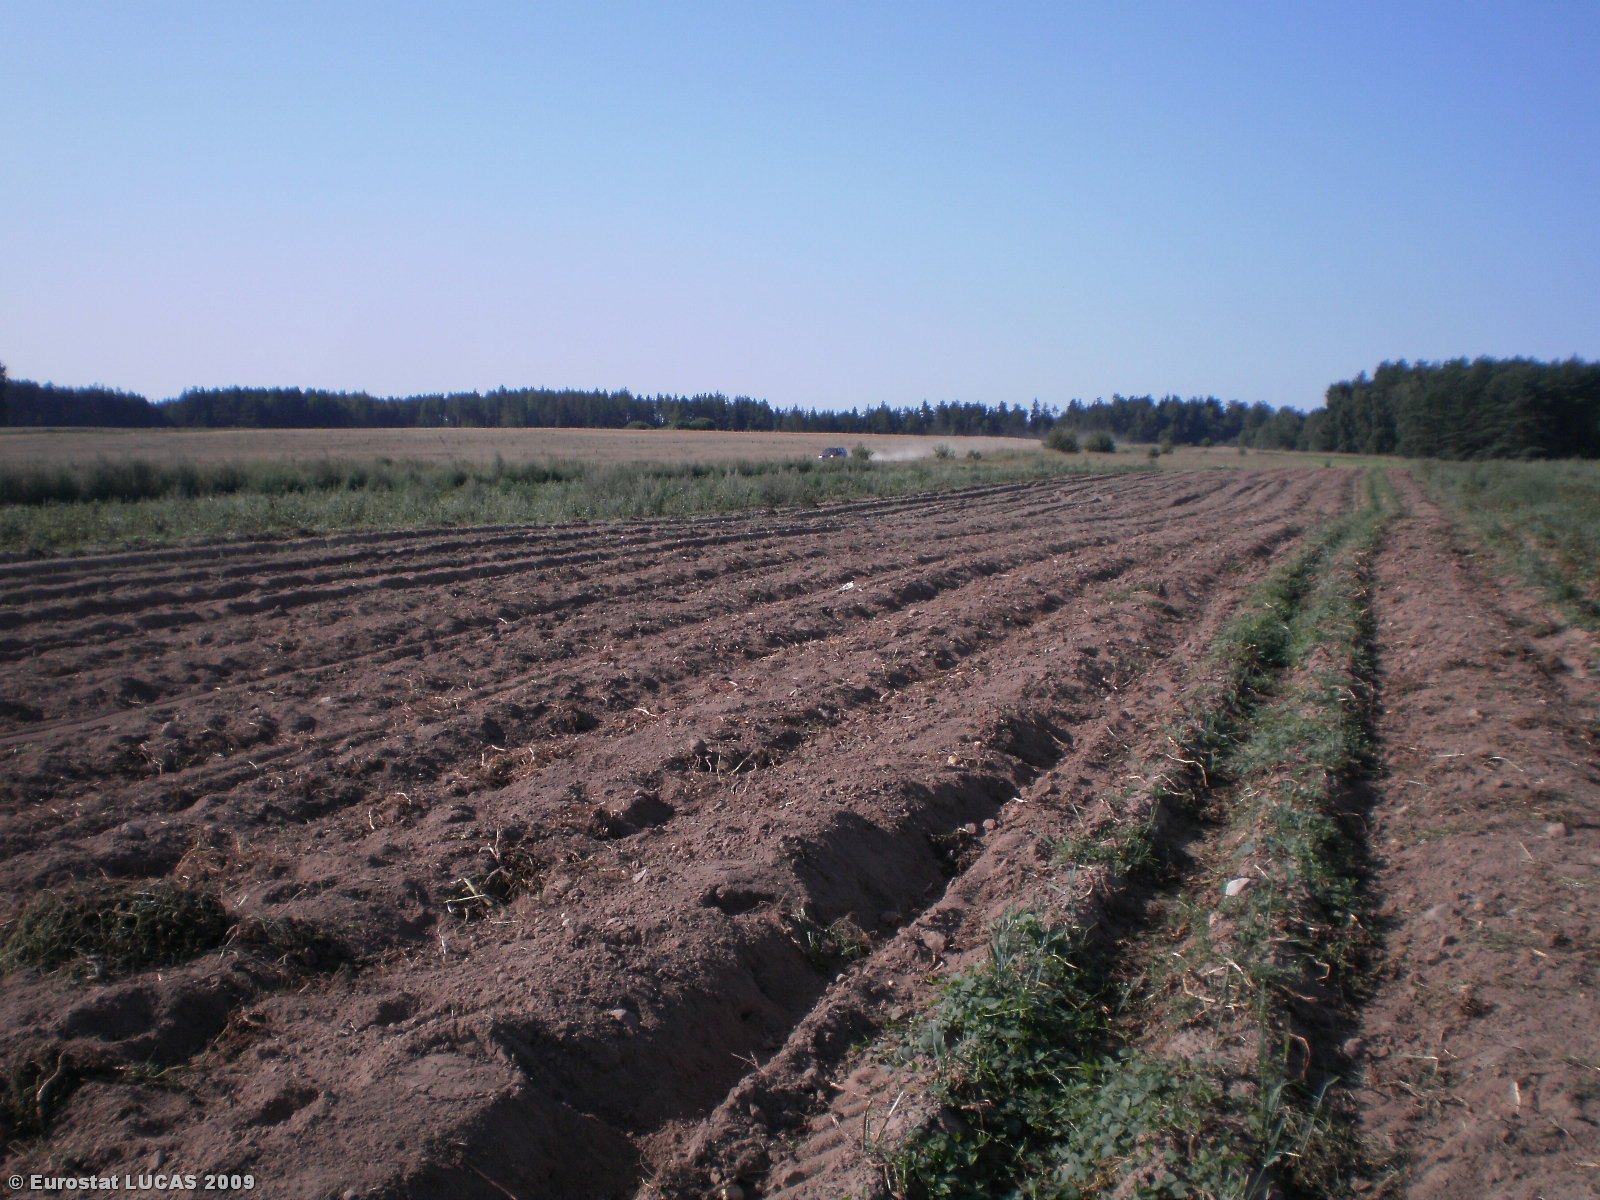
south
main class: Cropland
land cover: Potatoes
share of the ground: < 10 %
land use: Agriculture (excluding fallow land and kitchen gardens)
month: August
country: LT
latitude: 55.5906
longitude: 25.0111
